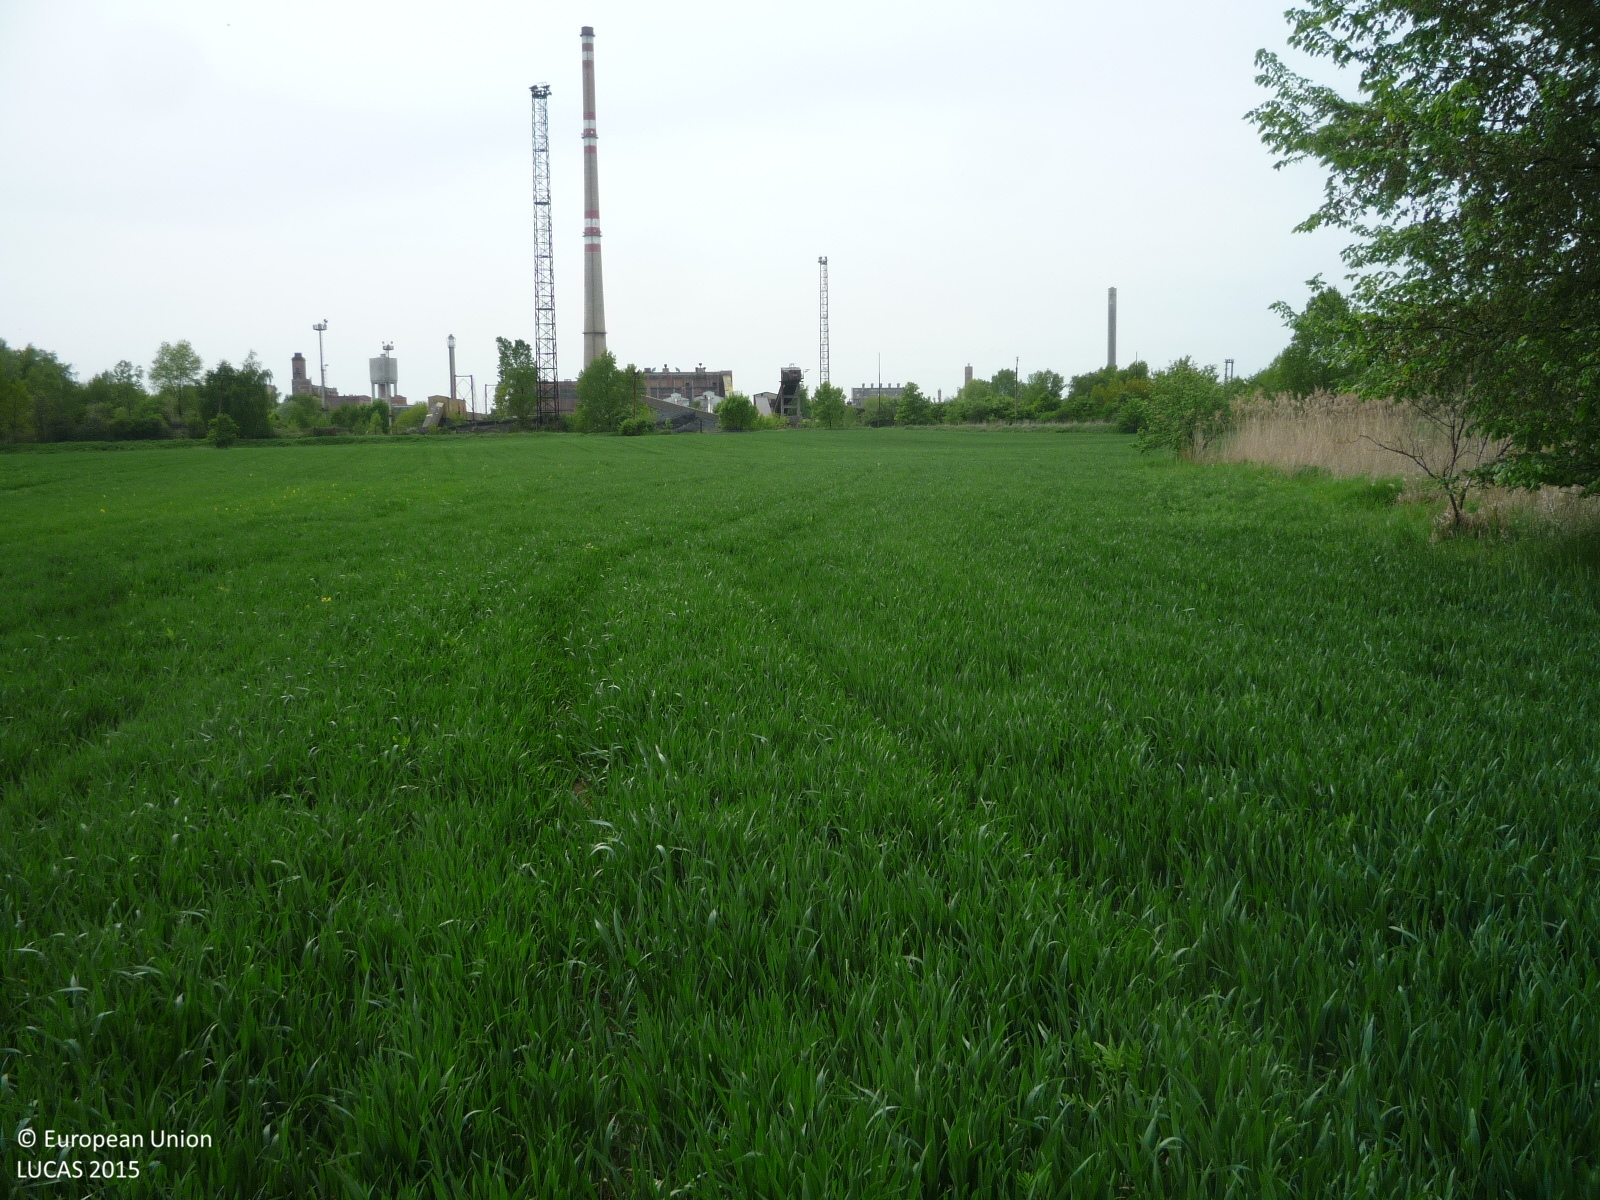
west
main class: Cropland
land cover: Common wheat
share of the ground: > 75 %
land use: Agriculture (excluding fallow land and kitchen gardens)
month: May
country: CZ
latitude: 50.2742
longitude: 14.5339
